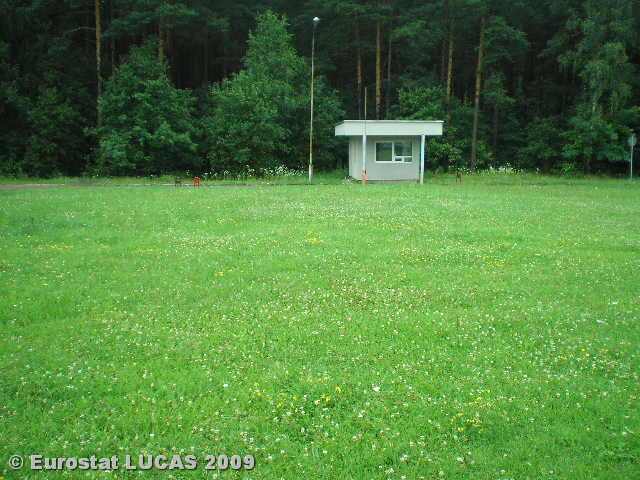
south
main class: Grassland
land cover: Grassland without tree/shrub cover
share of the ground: > 75 %
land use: Community services
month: July
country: LT
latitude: 54.6688
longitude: 25.2062
